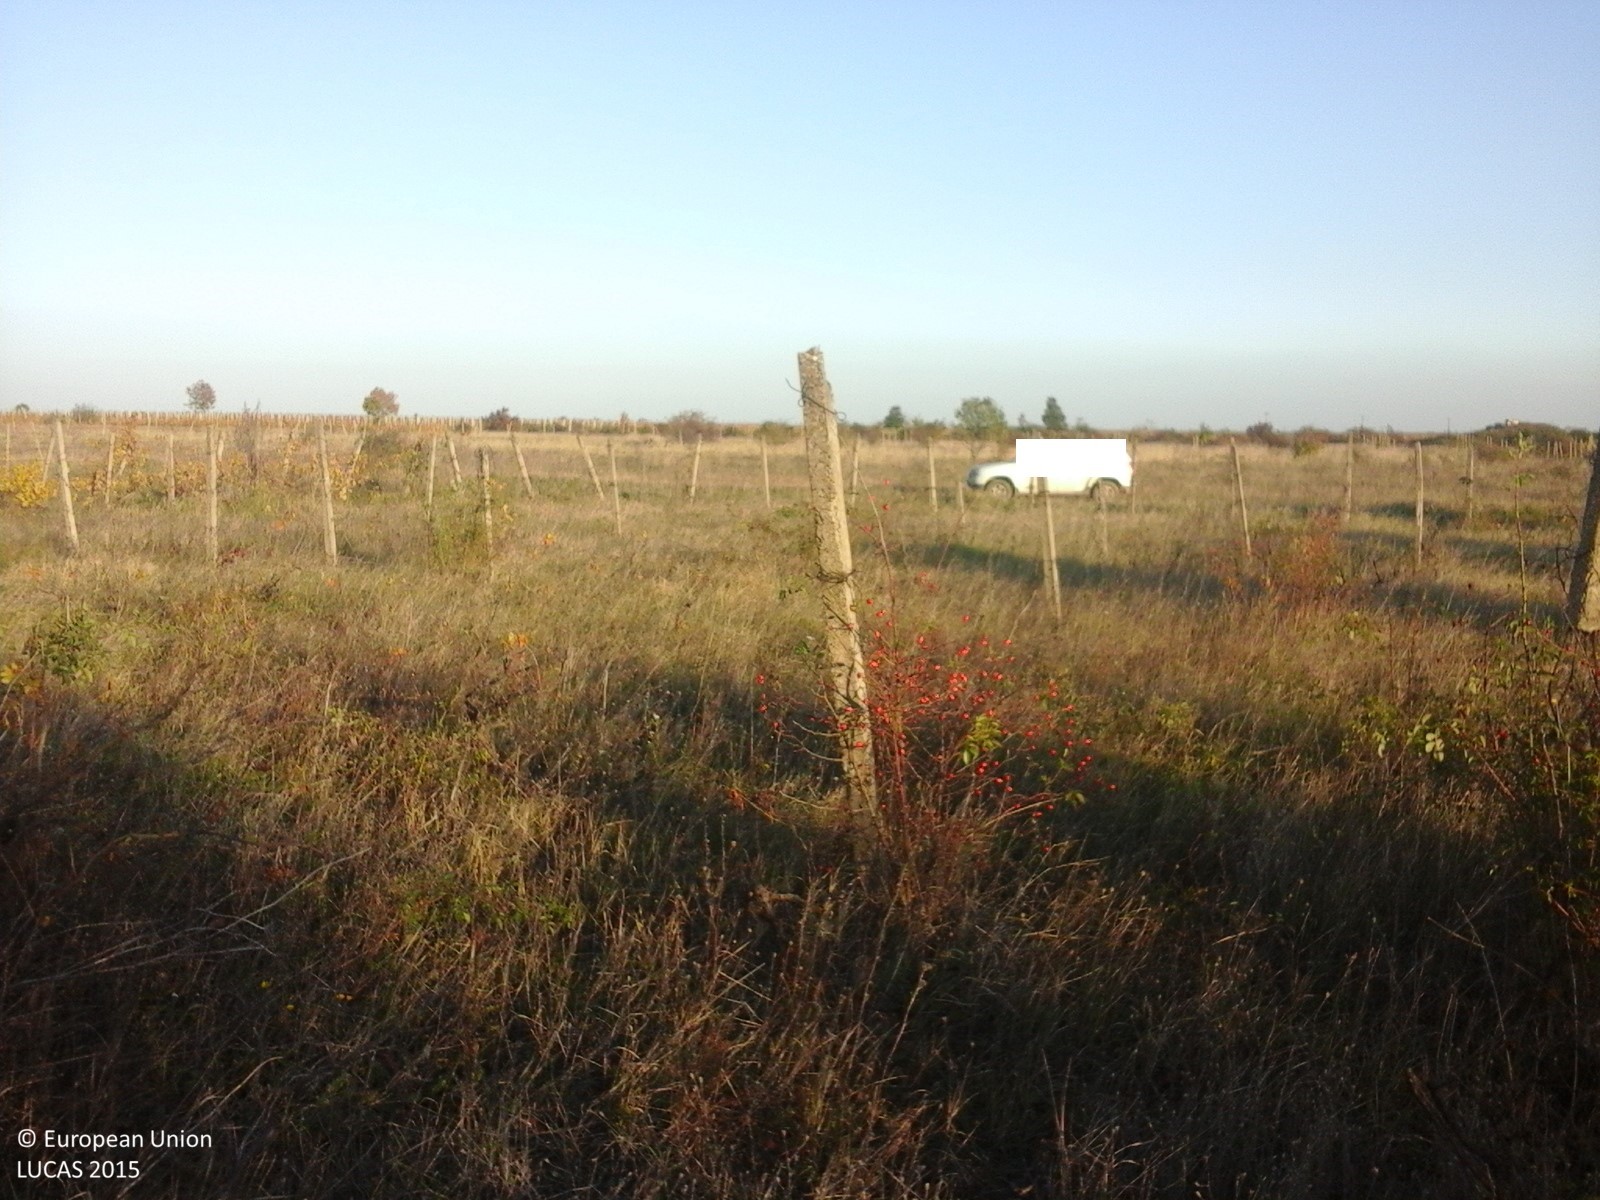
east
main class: Cropland
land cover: Vineyards
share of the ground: > 75 %
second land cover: Grassland without tree/shrub cover
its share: > 75 %
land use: Agriculture (excluding fallow land and kitchen gardens)
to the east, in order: Vineyards; Grassland without tree/shrub cover; Tracks; Grassland with sparse tree/shrub cover; Vineyards; Grass margins; Tracks
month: October
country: RO
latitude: 45.8085
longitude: 27.0919
